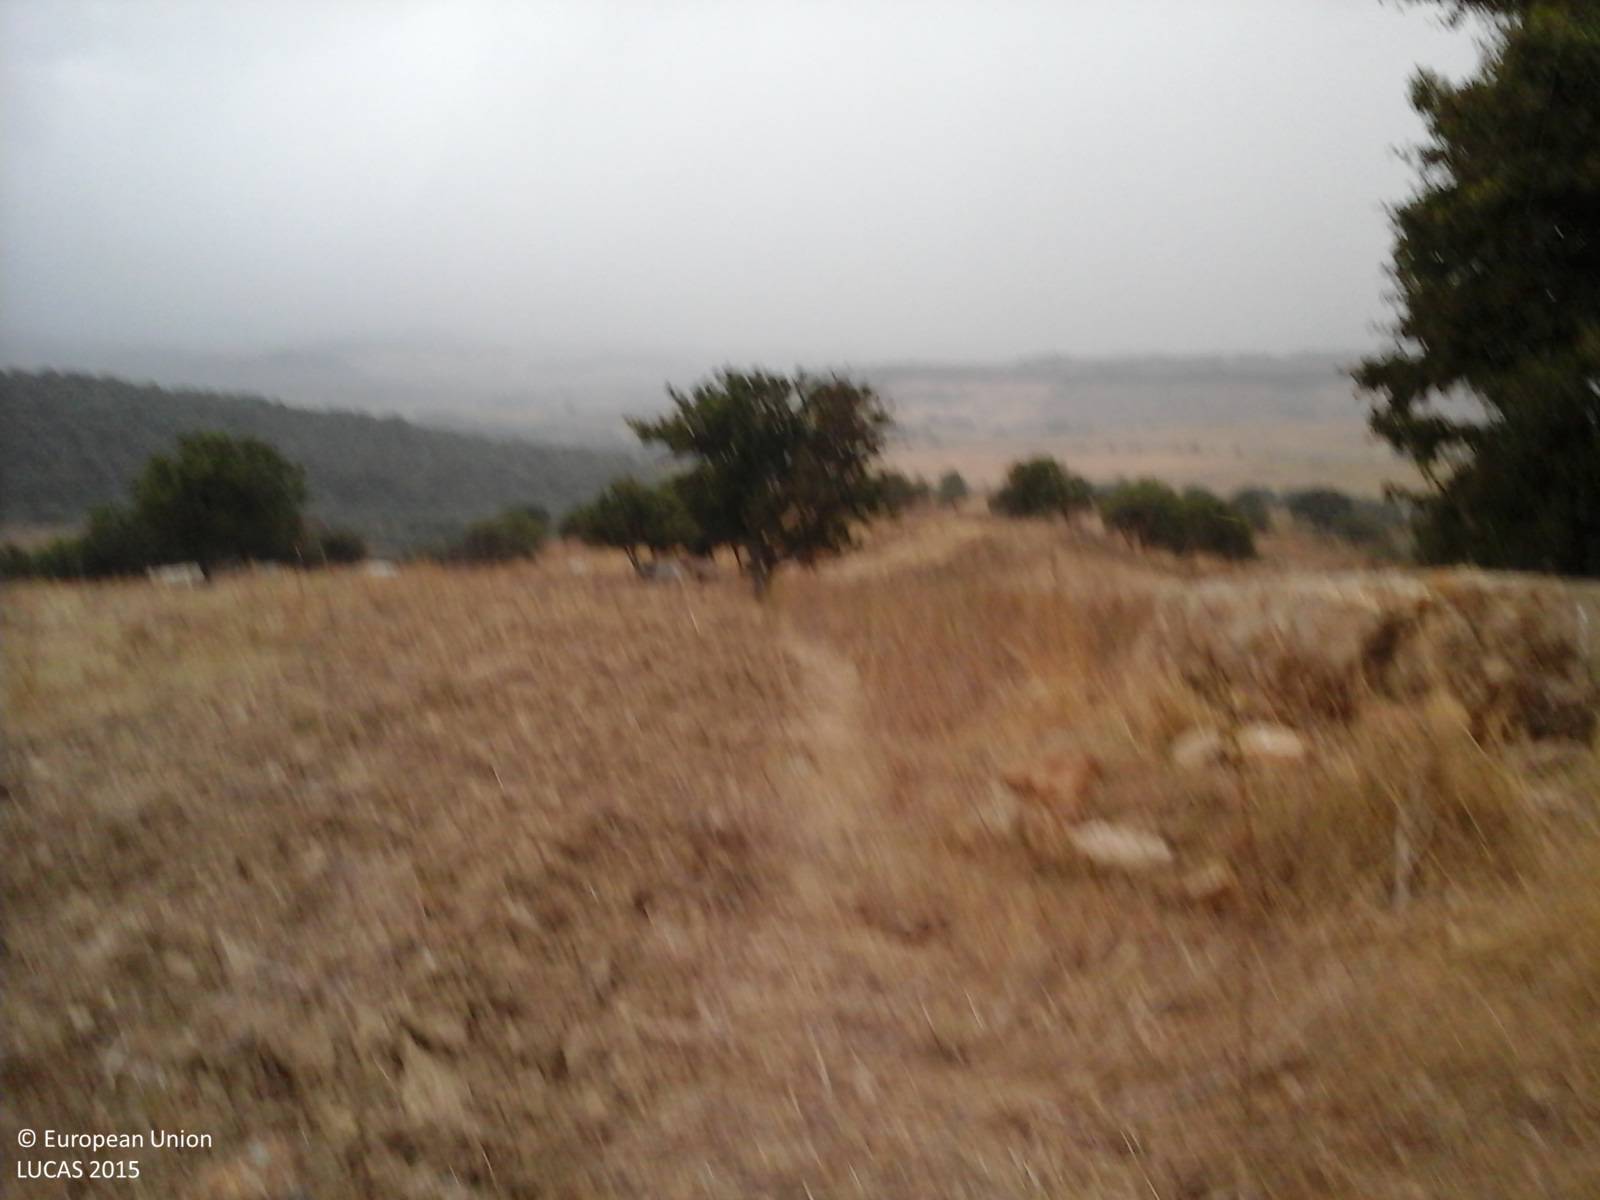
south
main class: Grassland
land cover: Grassland without tree/shrub cover
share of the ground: > 75 %
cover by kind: herbaceous plants 90 %
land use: Agriculture (excluding fallow land and kitchen gardens)
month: August
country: IT
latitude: 42.2568
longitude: 11.8963
